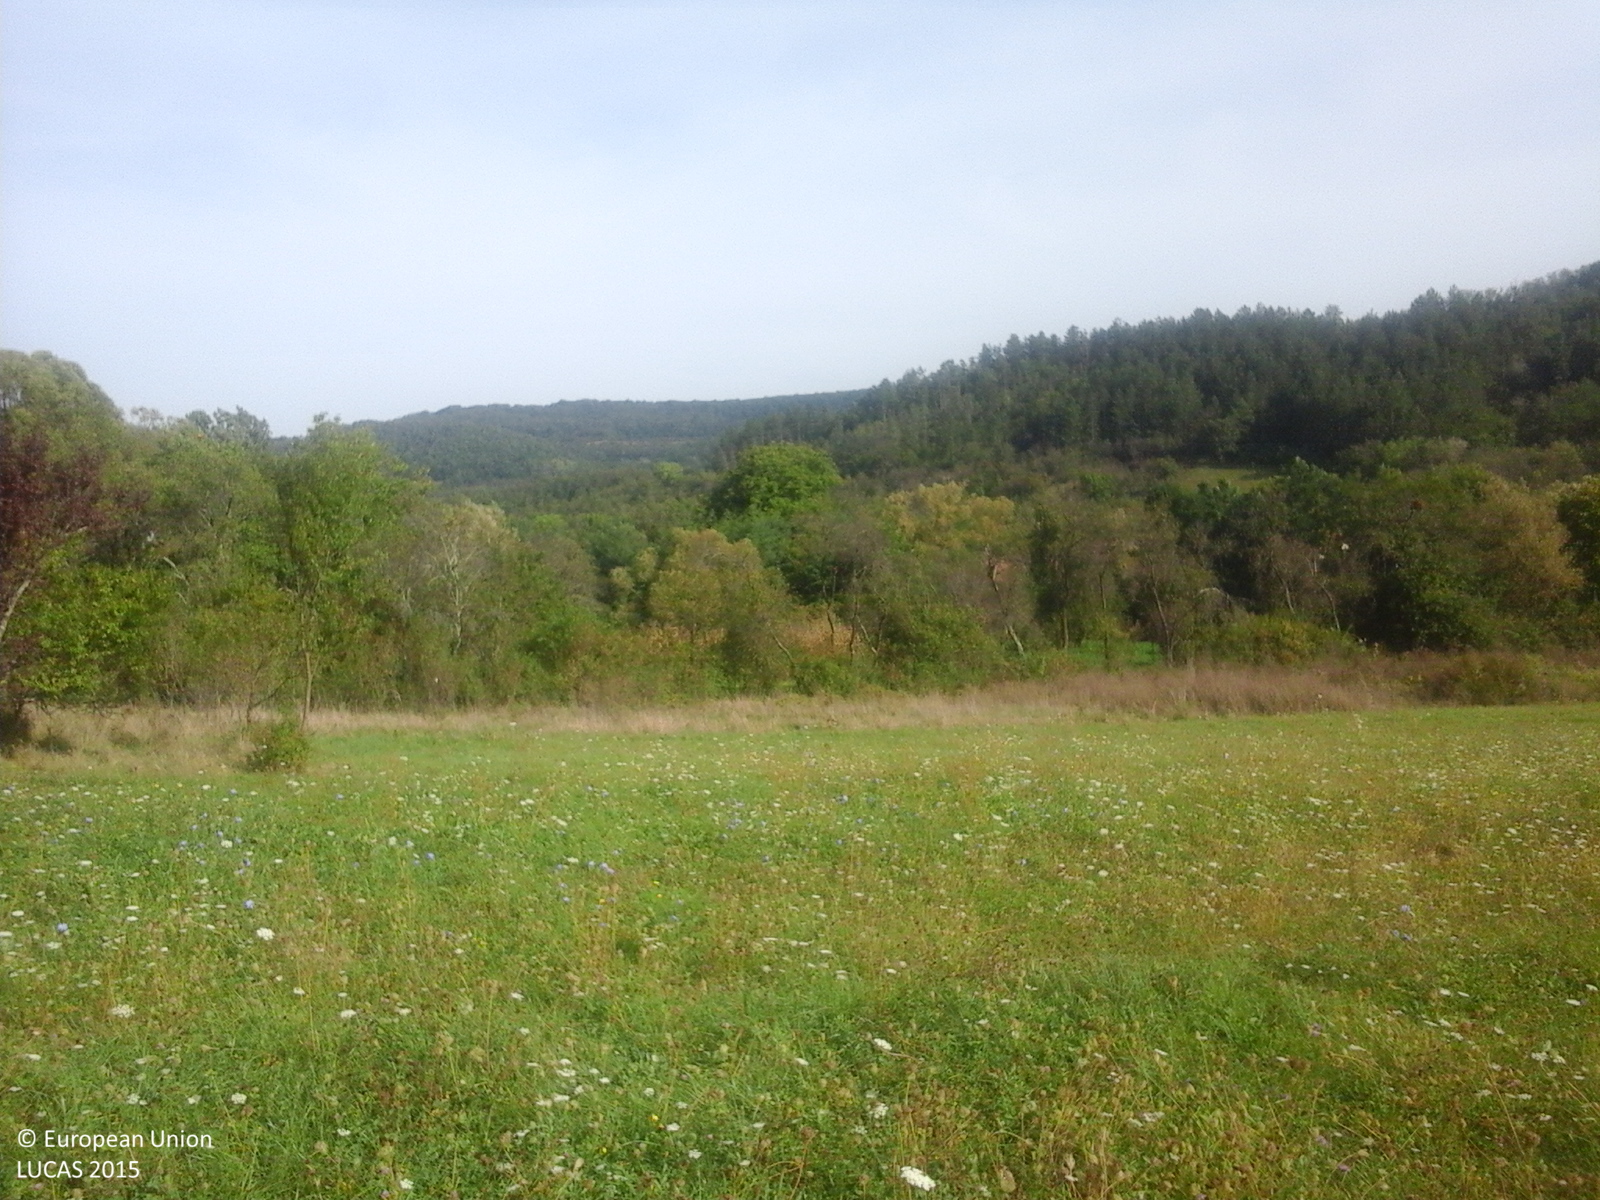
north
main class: Grassland
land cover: Grassland without tree/shrub cover
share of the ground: > 75 %
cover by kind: herbaceous plants 100 %
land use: Agriculture (excluding fallow land and kitchen gardens)
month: September
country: RO
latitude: 46.9509
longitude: 23.3516
